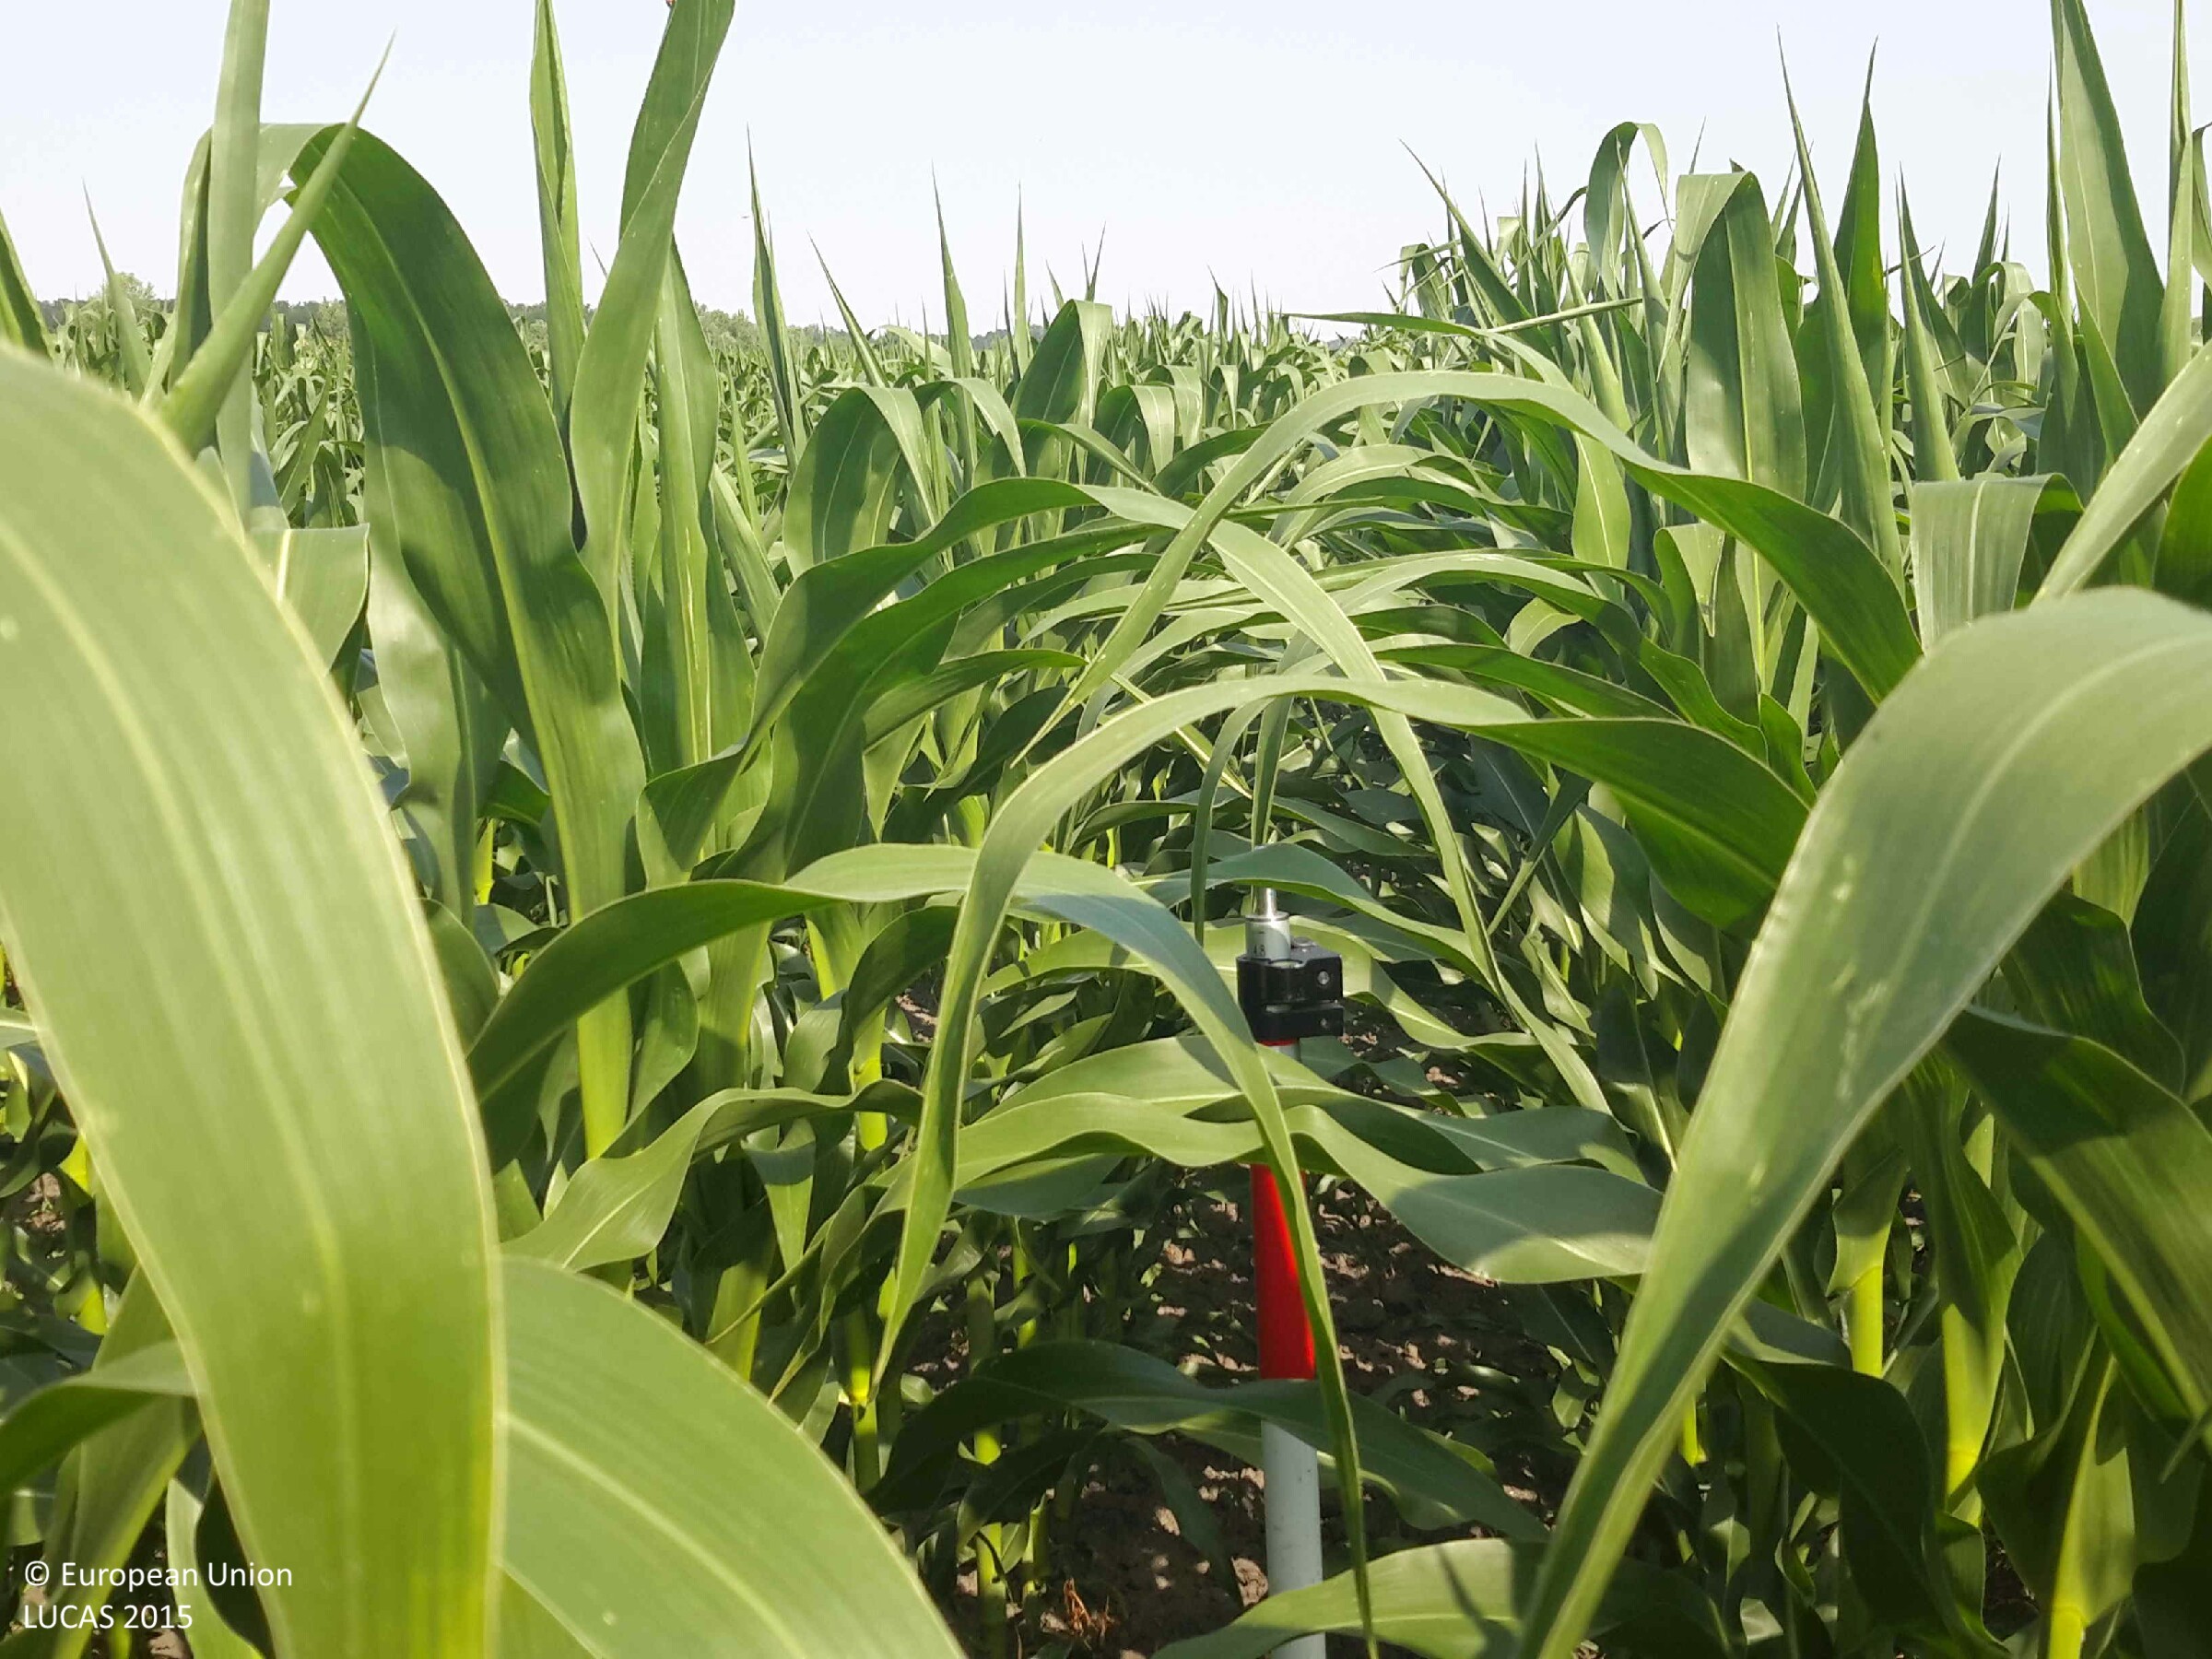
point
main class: Cropland
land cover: Maize
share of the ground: > 75 %
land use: Agriculture (excluding fallow land and kitchen gardens)
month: July
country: HU
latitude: 47.3703
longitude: 17.5164
